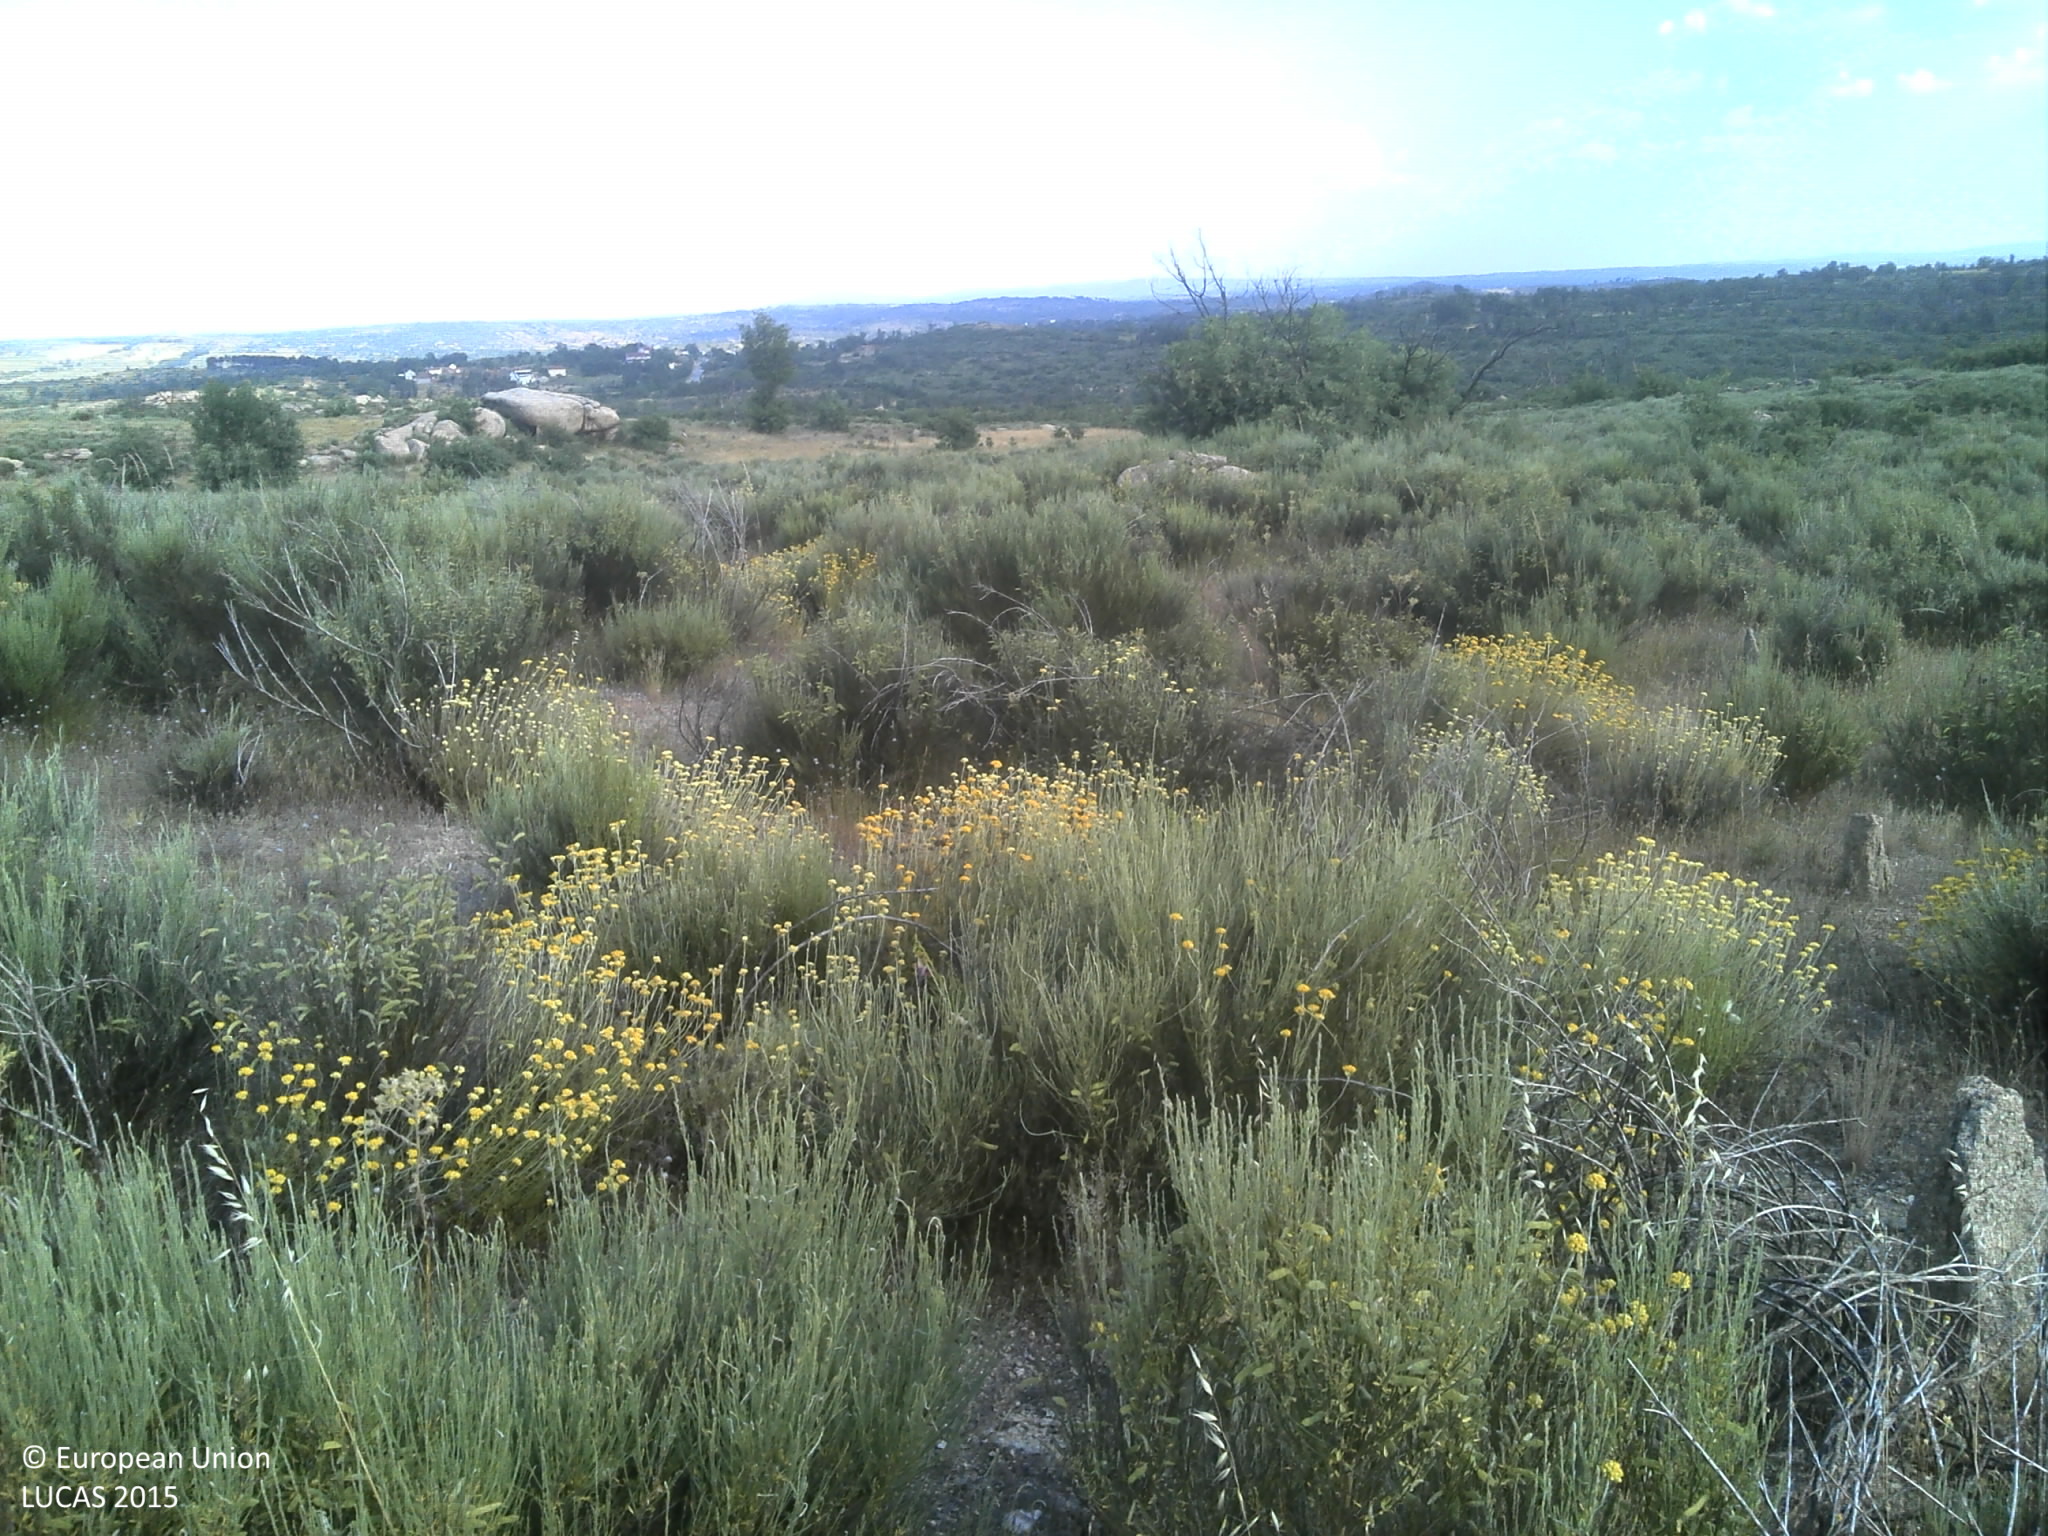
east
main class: Shrubland
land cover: Shrubland without tree cover
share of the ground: 50 - 75 %
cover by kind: shrubs 65 %, unconsolidated bare surface 15 %, herbaceous plants 10 %, consolidated bare surface 10 %
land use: Semi-natural and natural areas not in use
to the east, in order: Shrubland without tree cover; Rocks and stones; Shrubland without tree cover; Grassland without tree/shrub cover; Tracks; Grassland without tree/shrub cover; Rocks and stones; Shrubland without tree cover; Rocks and stones; Shrubland without tree cover
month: June
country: PT
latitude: 40.4948
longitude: -7.0550
